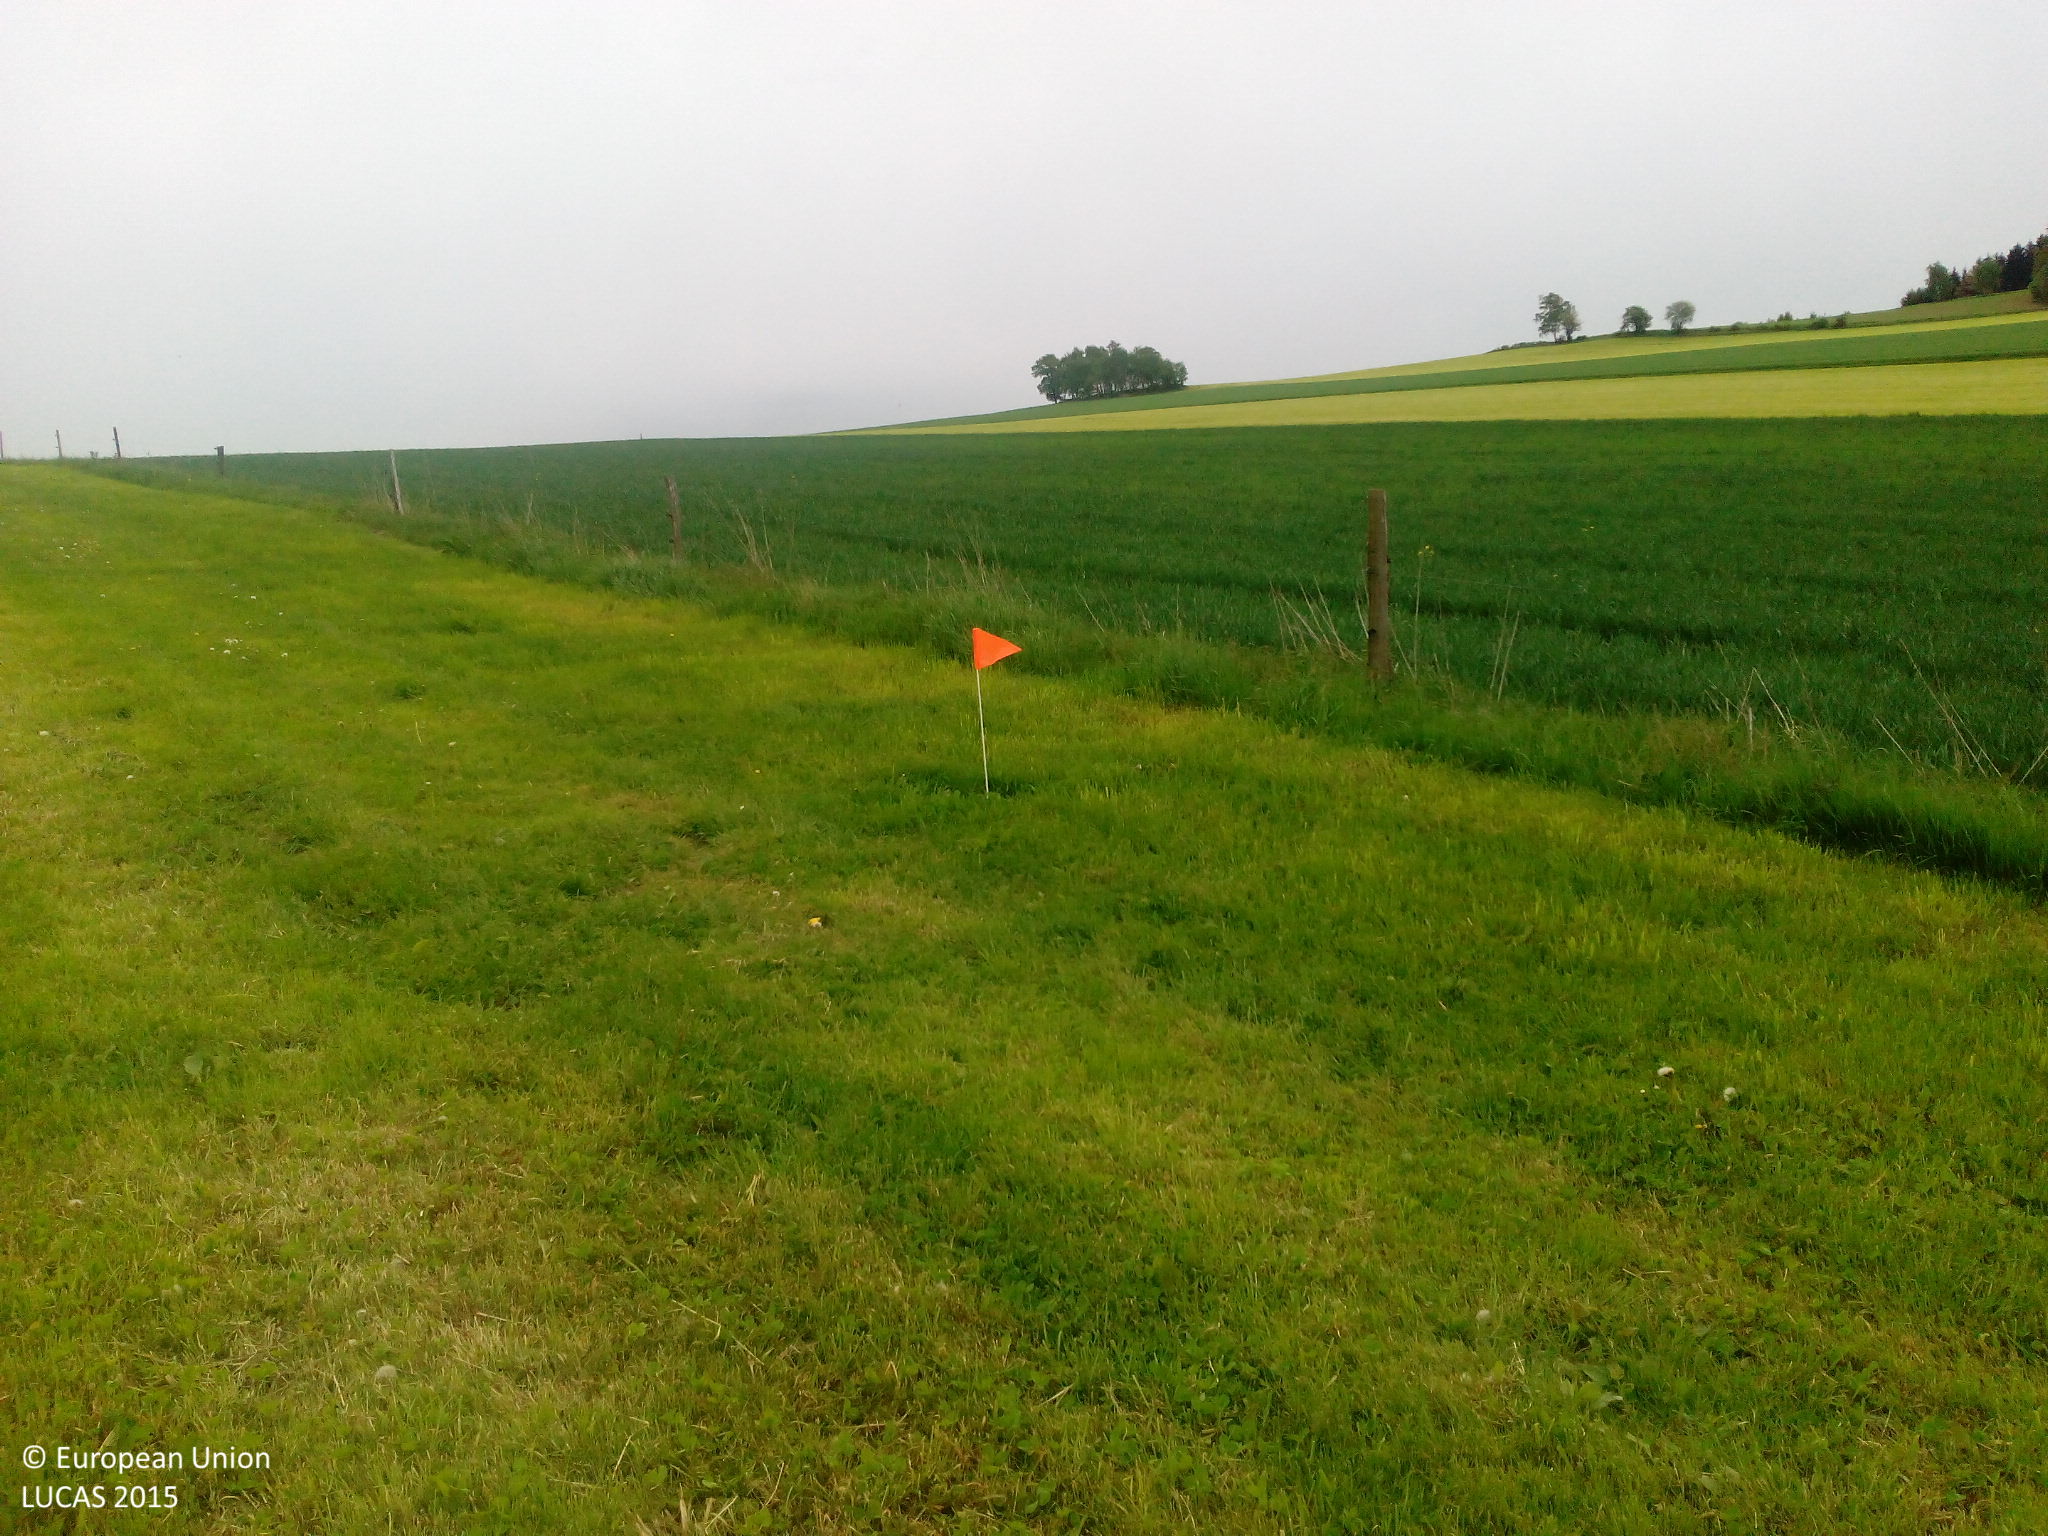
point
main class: Grassland
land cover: Grassland without tree/shrub cover
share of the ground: > 75 %
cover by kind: herbaceous plants 100 %
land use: Agriculture (excluding fallow land and kitchen gardens)
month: May
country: DE
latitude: 50.7186
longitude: 13.0737
